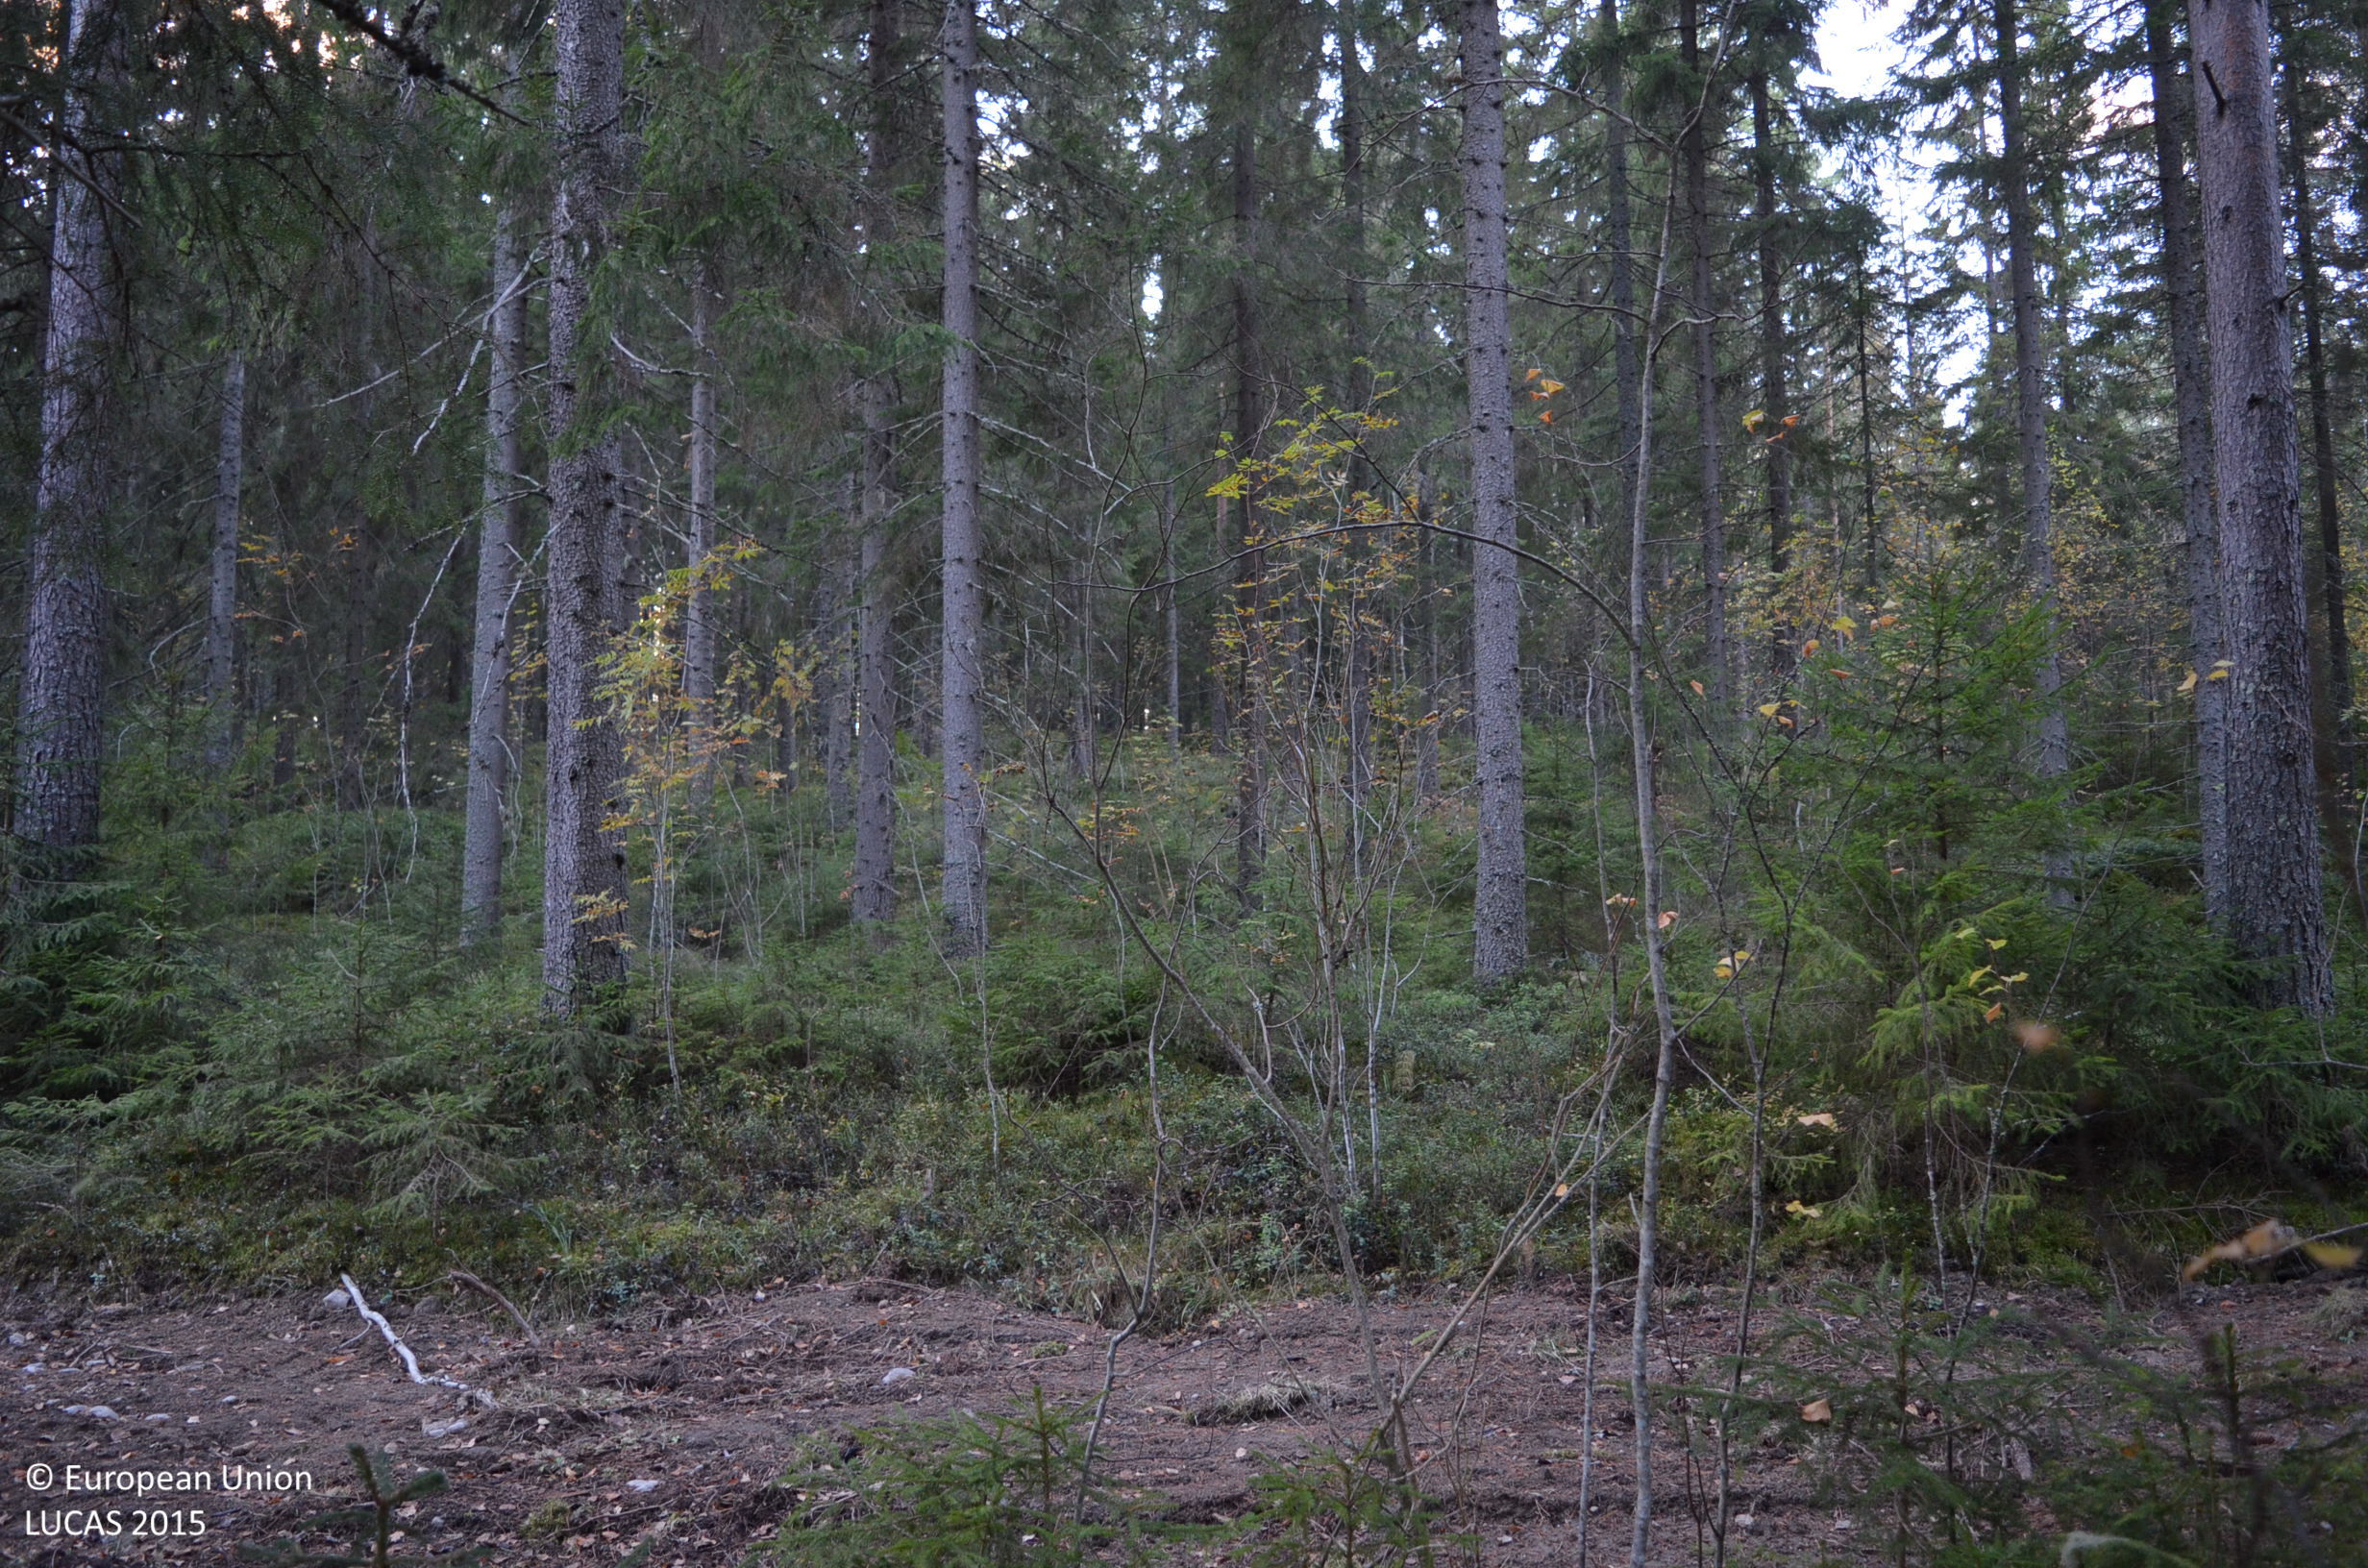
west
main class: Woodland
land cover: Spruce dominated coniferous woodland
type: boreal forest
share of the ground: > 75 %
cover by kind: coniferous forest trees 60 %, shrubs 20 %, broadleaved forest trees 15 %, lichens and mosses 5 %
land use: Forestry
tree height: > 5 m
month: October
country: FI
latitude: 61.7442
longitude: 23.8882
